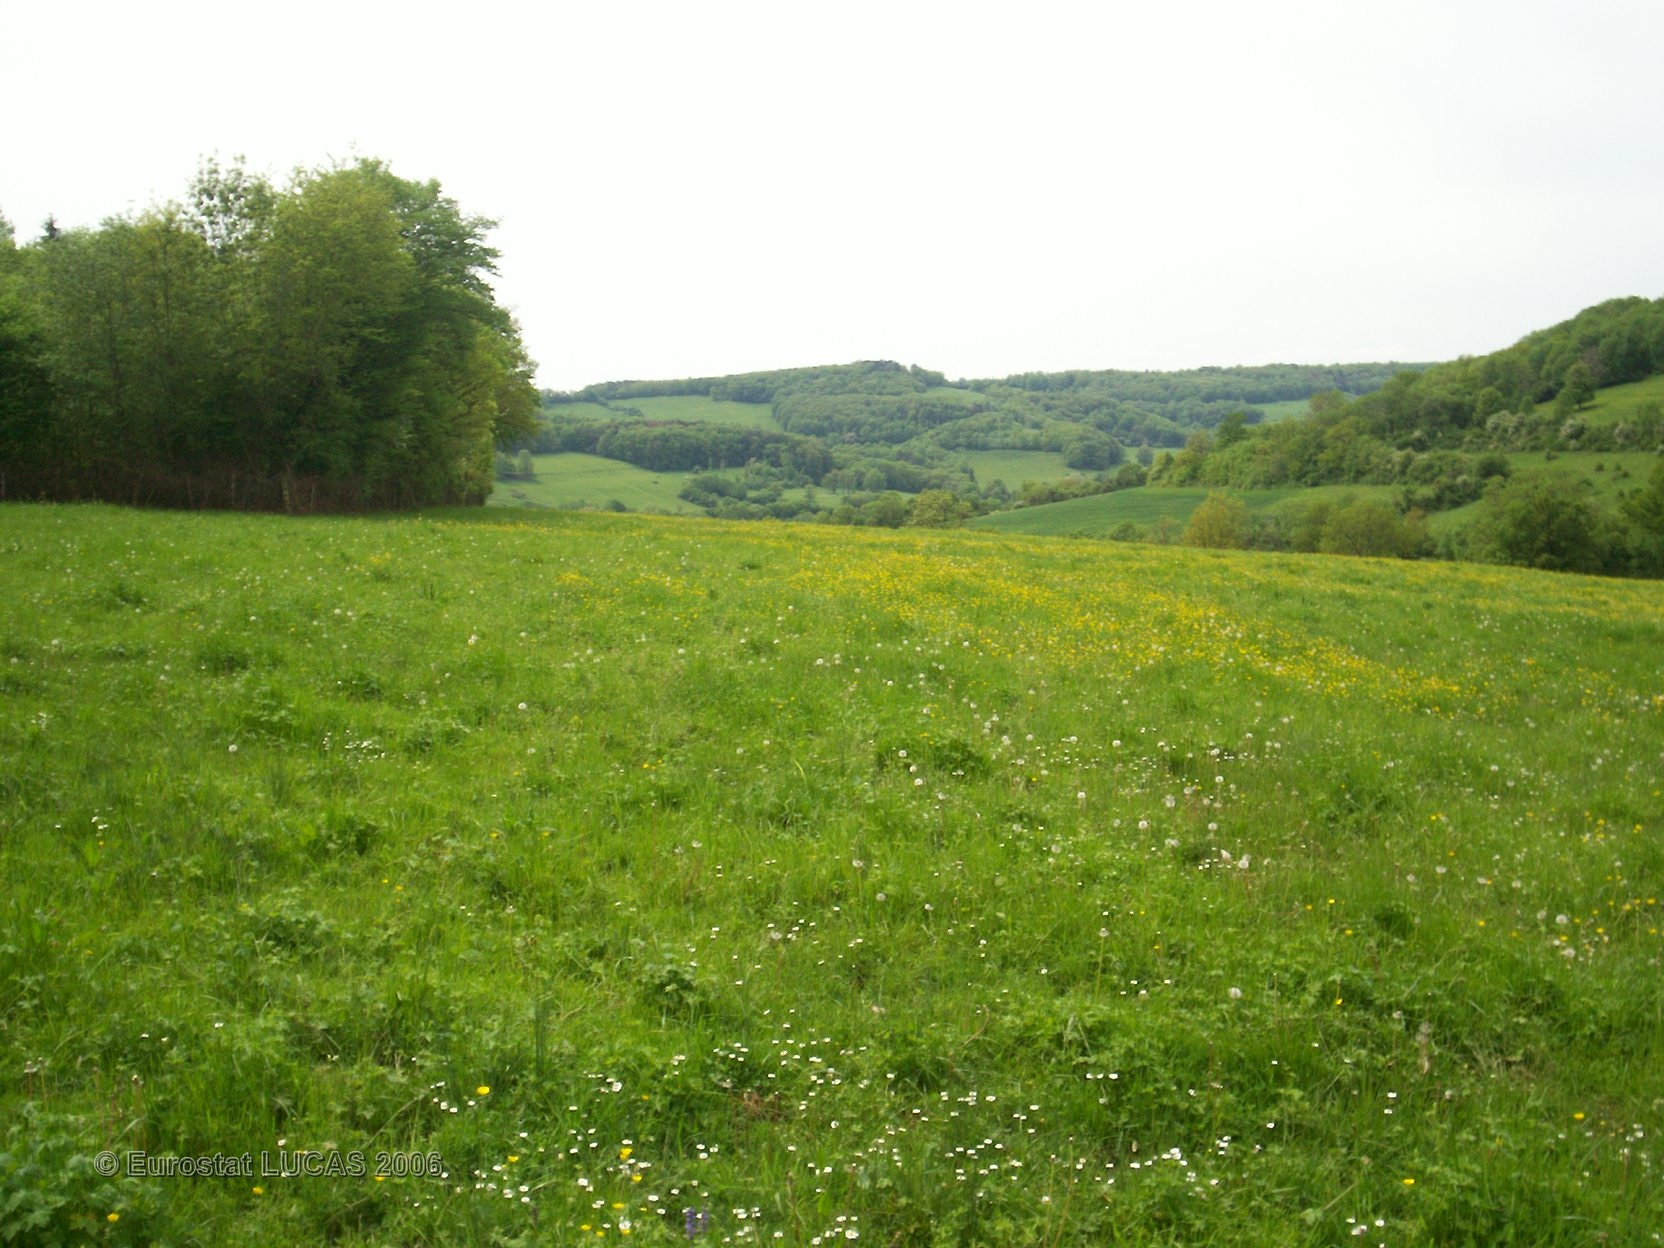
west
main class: Grassland
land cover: Grassland without tree/shrub cover
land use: Agriculture (excluding fallow land and kitchen gardens)
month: May
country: FR
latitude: 47.3164
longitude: 4.6154
